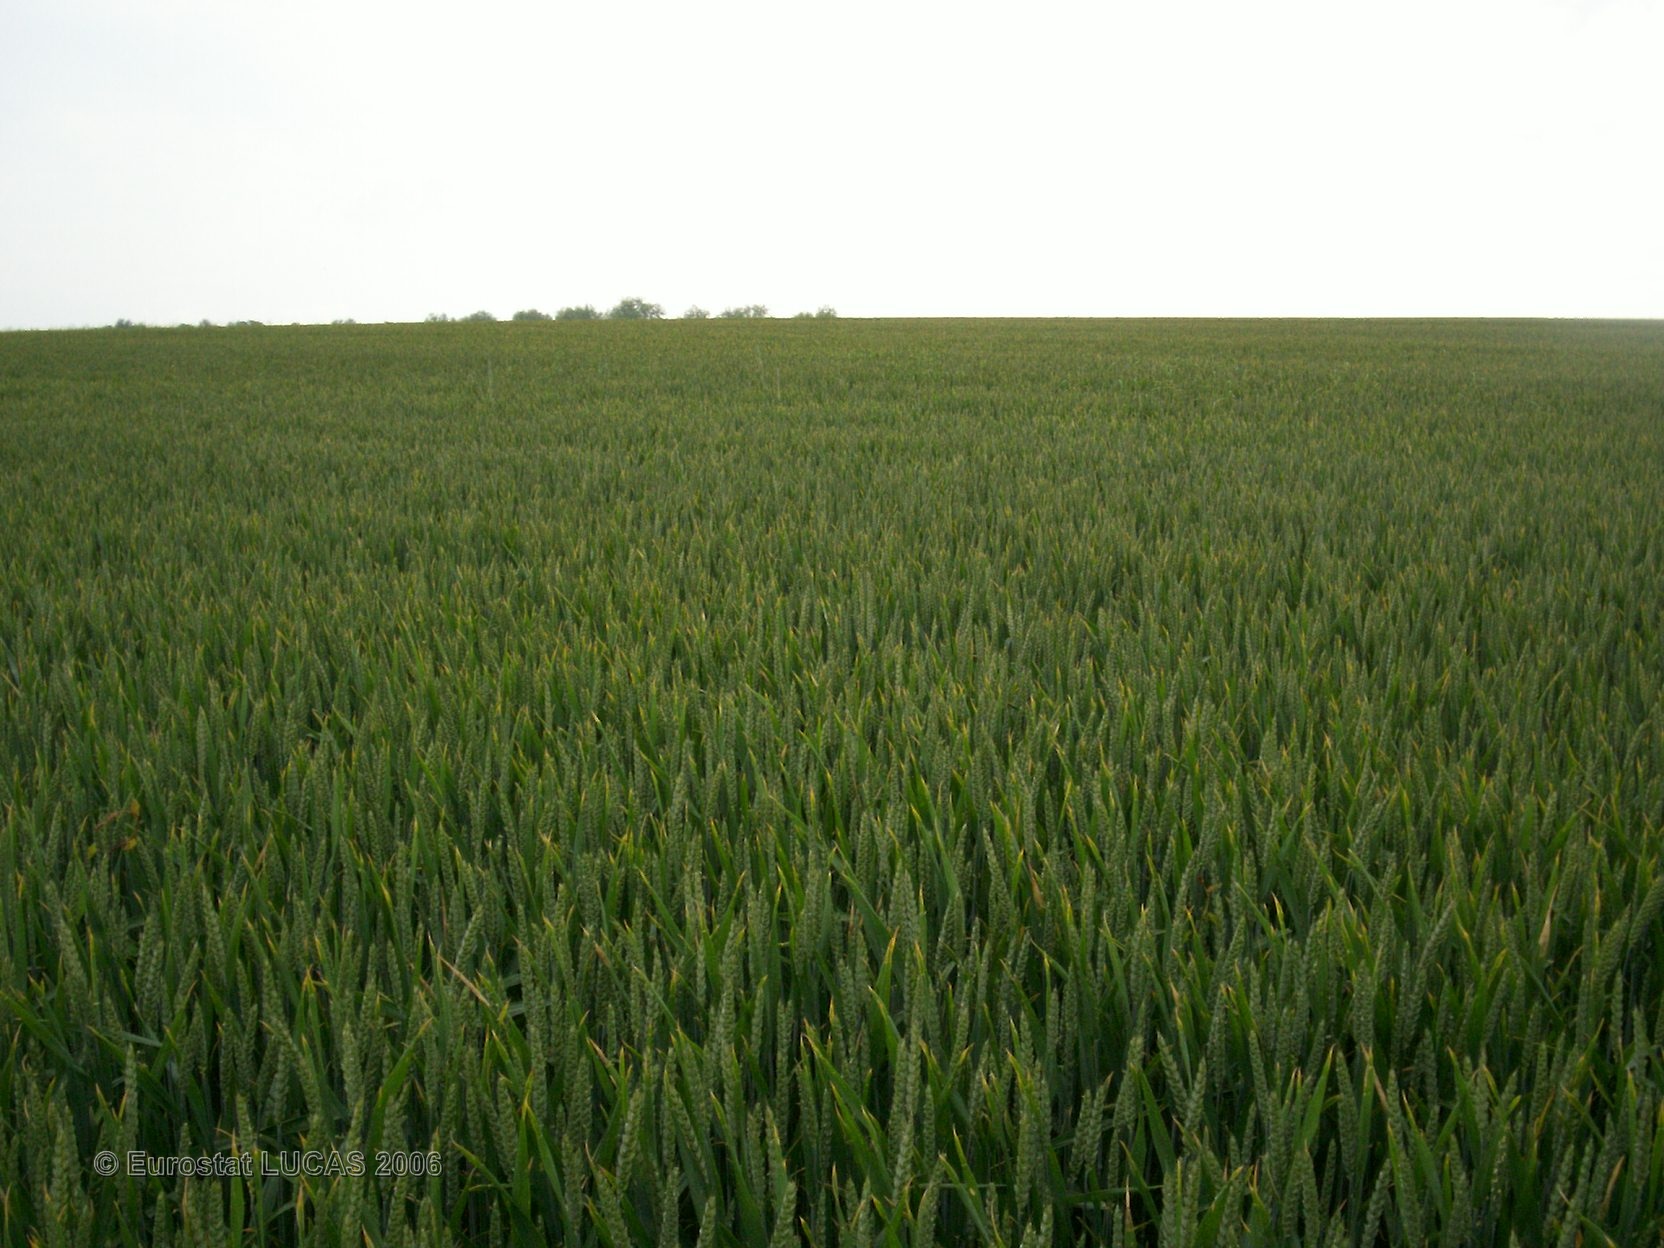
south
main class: Cropland
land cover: Common wheat
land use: Agriculture (excluding fallow land and kitchen gardens)
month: June
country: FR
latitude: 48.5623
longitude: 4.6451
